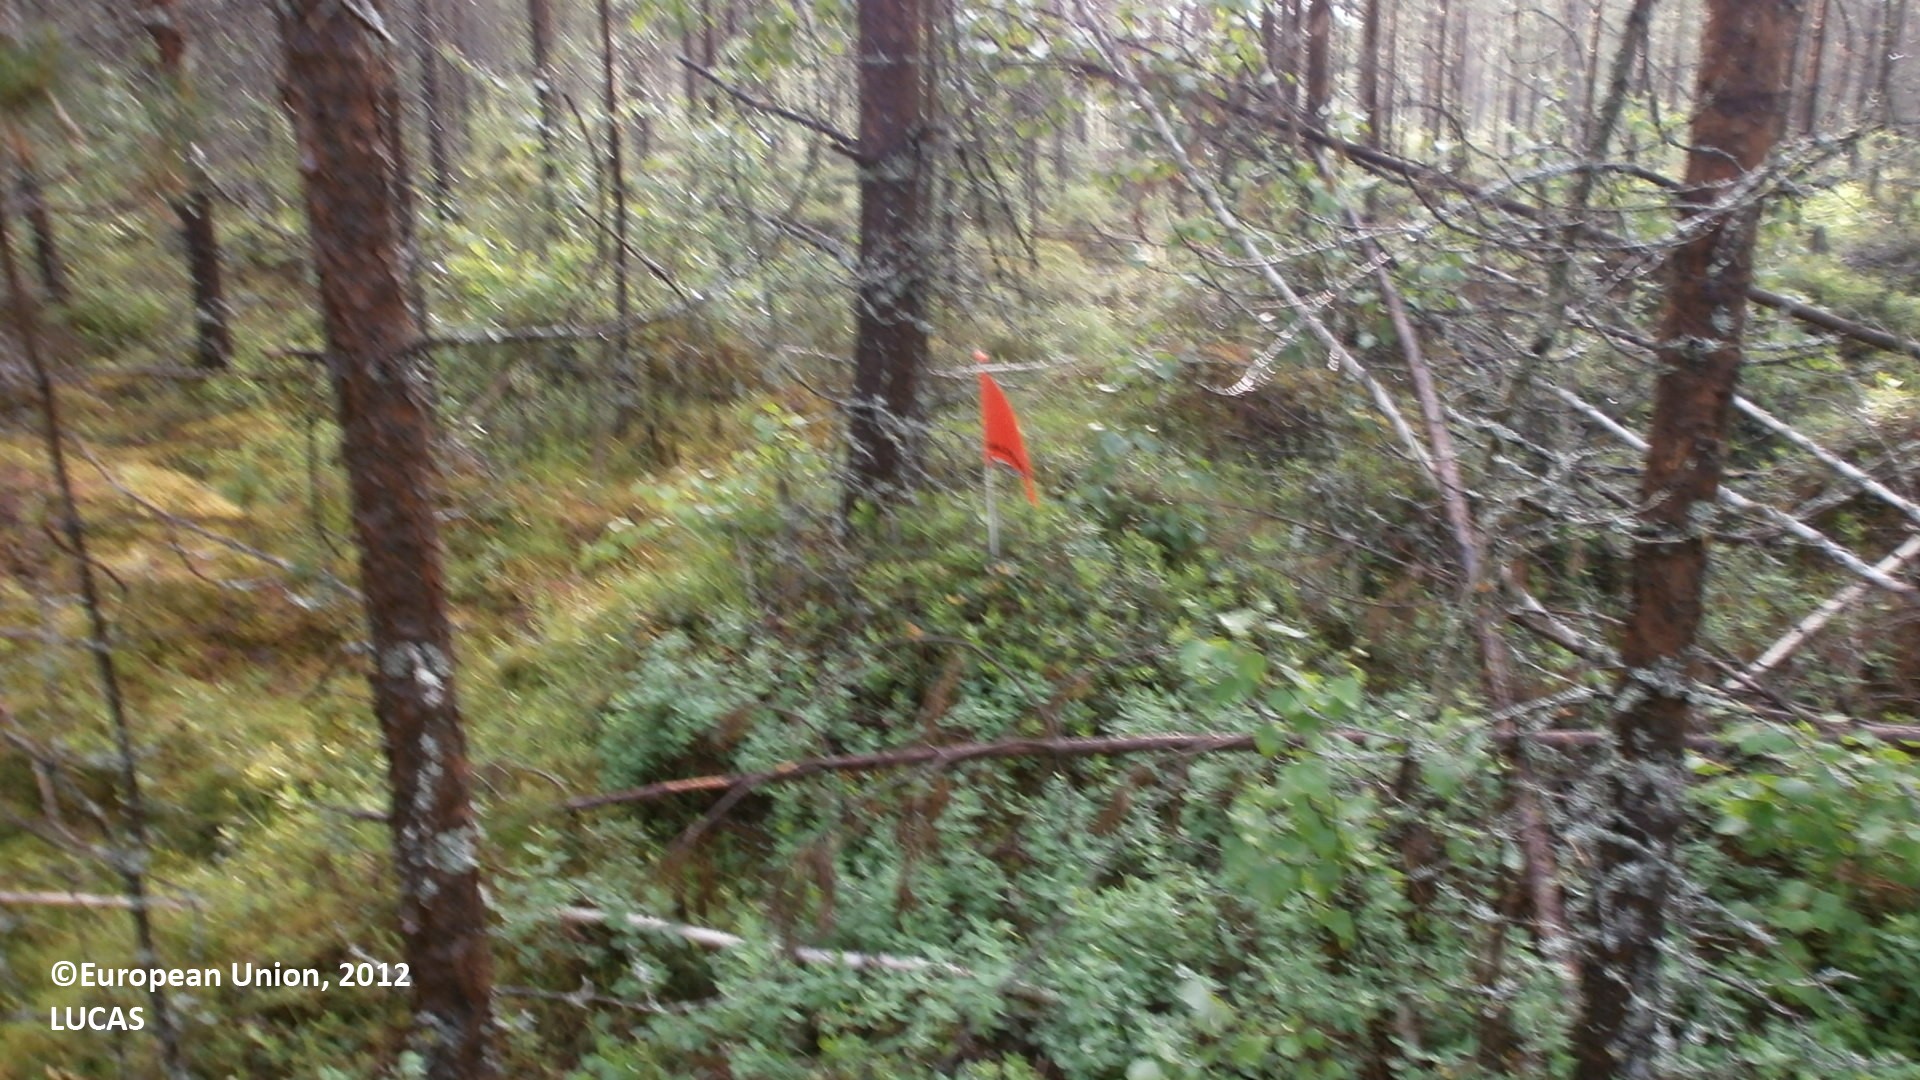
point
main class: Woodland
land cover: Pine dominated coniferous woodland
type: mire and swamp forests
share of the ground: 50 - 75 %
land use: Forestry
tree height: > 5 m
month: June
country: FI
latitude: 64.8075
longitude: 25.1758
